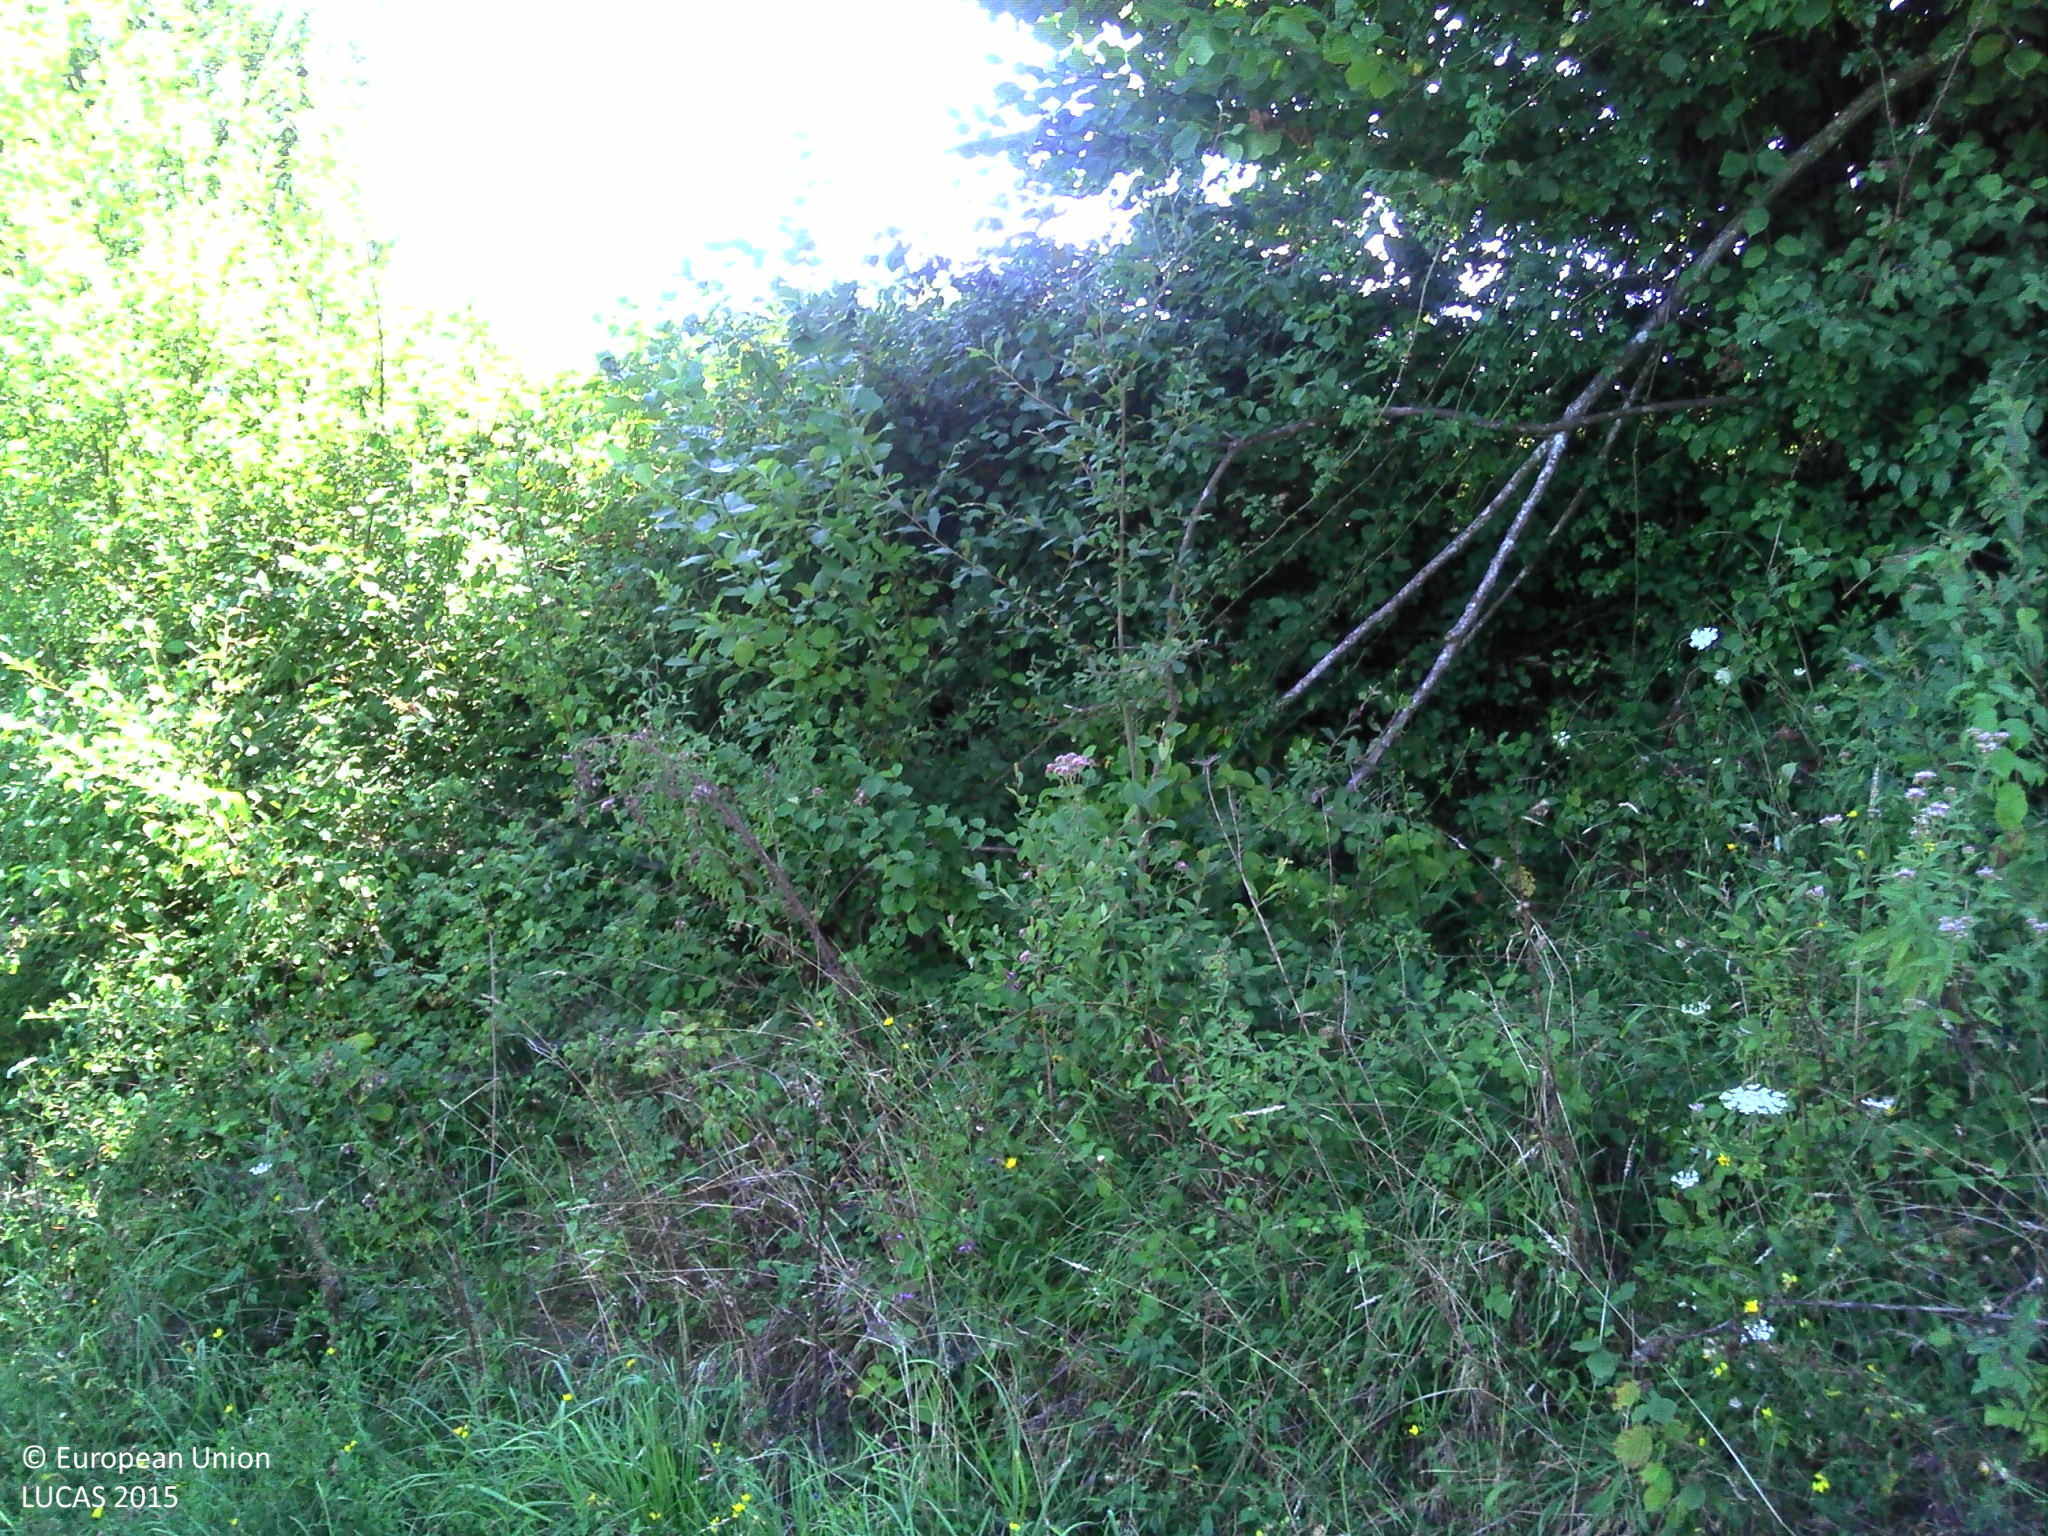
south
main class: Cropland
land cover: Temporary grasslands
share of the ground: > 75 %
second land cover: Lucerne
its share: 10 - 25 %
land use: Agriculture (excluding fallow land and kitchen gardens)
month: August
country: FR
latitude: 43.3167
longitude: -1.0981
